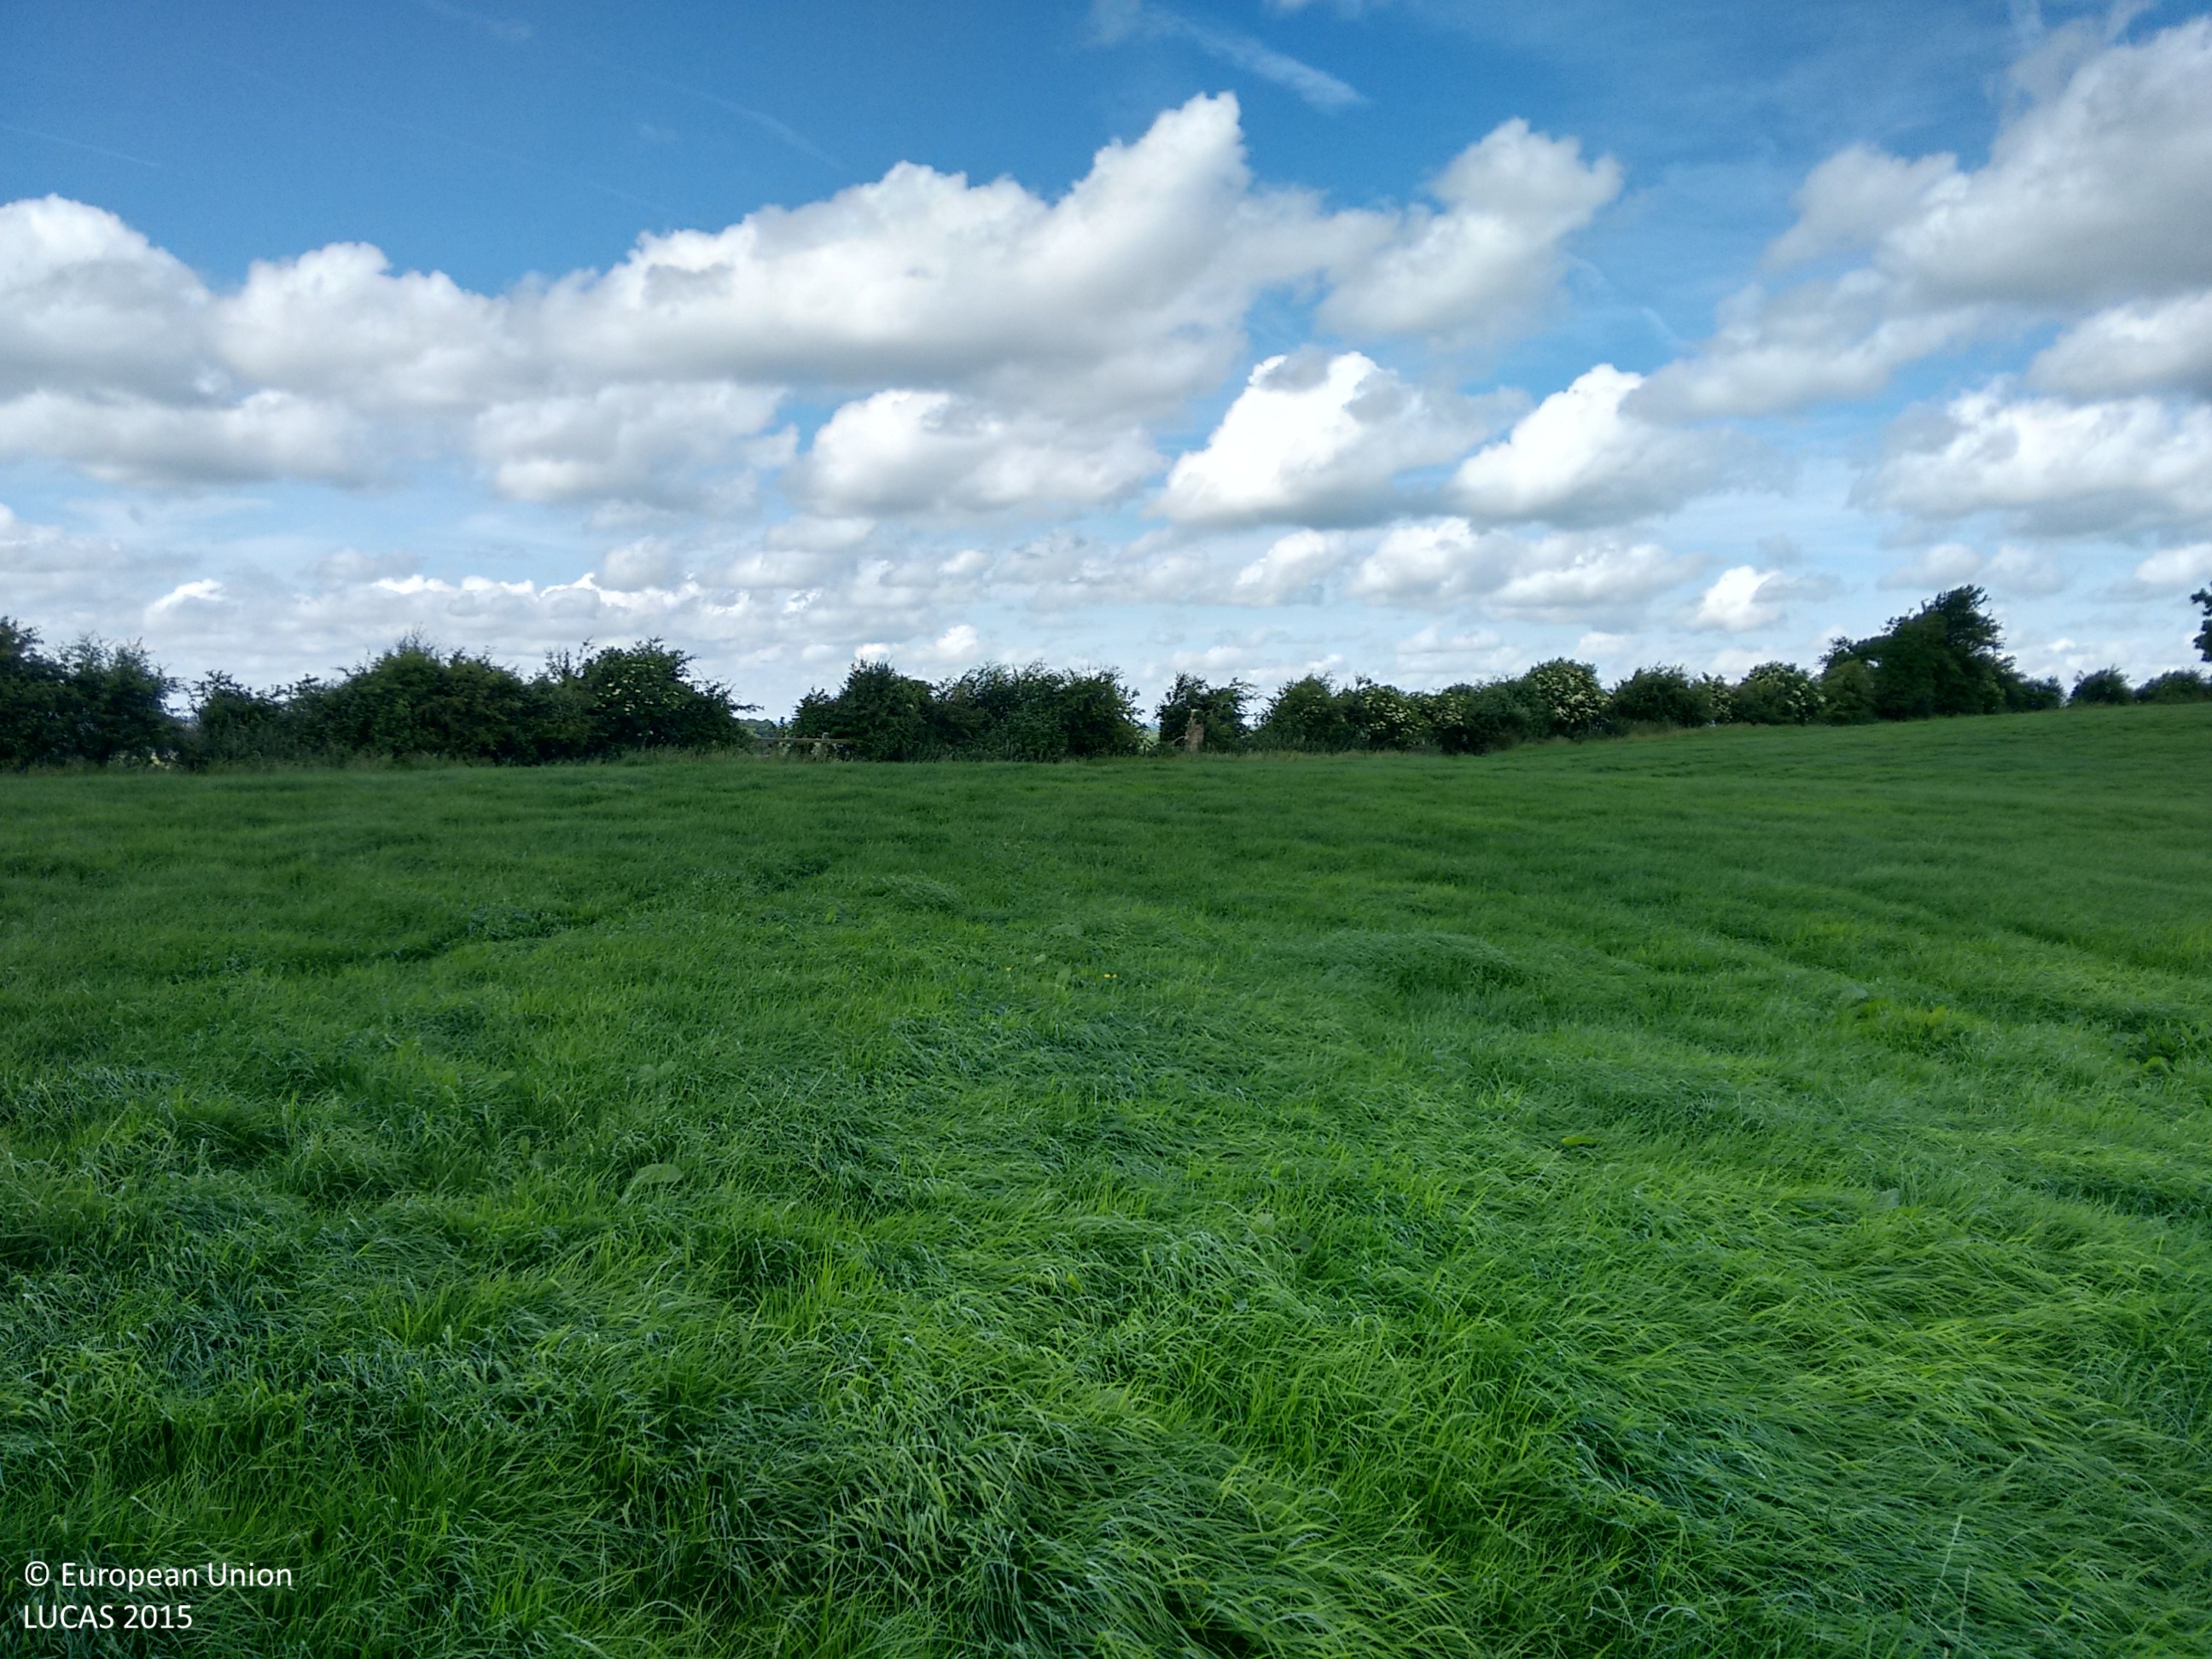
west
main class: Grassland
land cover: Grassland without tree/shrub cover
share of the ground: > 75 %
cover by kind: herbaceous plants 100 %
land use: Agriculture (excluding fallow land and kitchen gardens)
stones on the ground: < 10 %
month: July
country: IE
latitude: 53.7858
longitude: -6.7534
